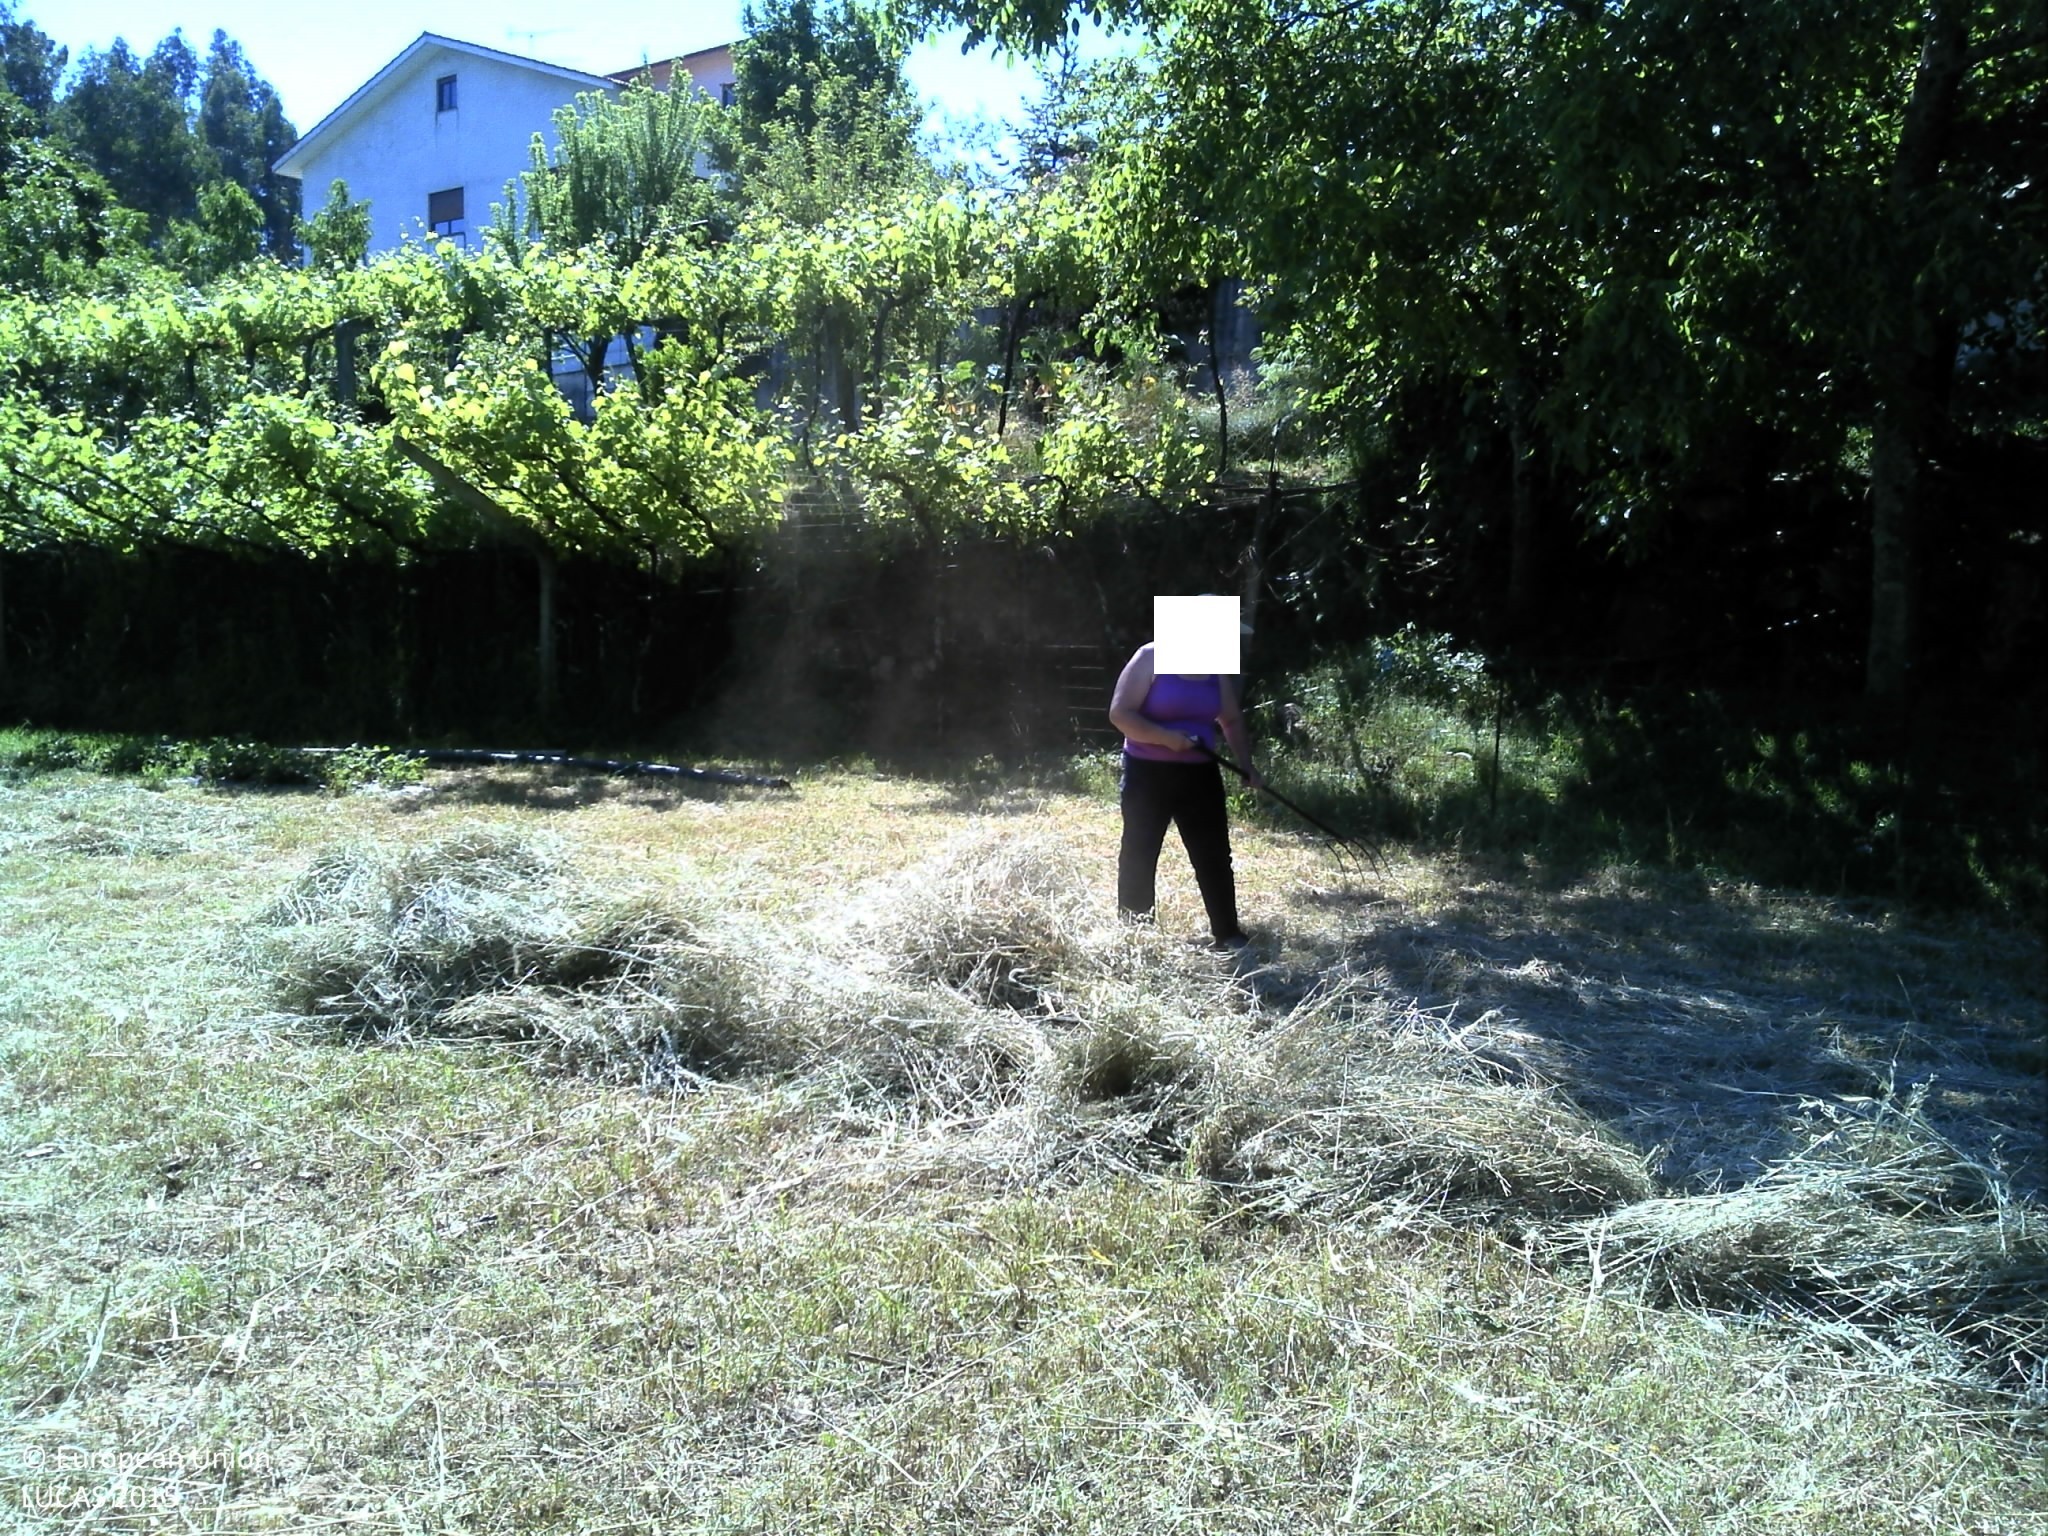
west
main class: Cropland
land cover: Temporary grasslands
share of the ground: 25 - 50 %
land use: Agriculture (excluding fallow land and kitchen gardens)
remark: Harvested field
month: May
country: PT
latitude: 41.6932
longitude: -8.5802
